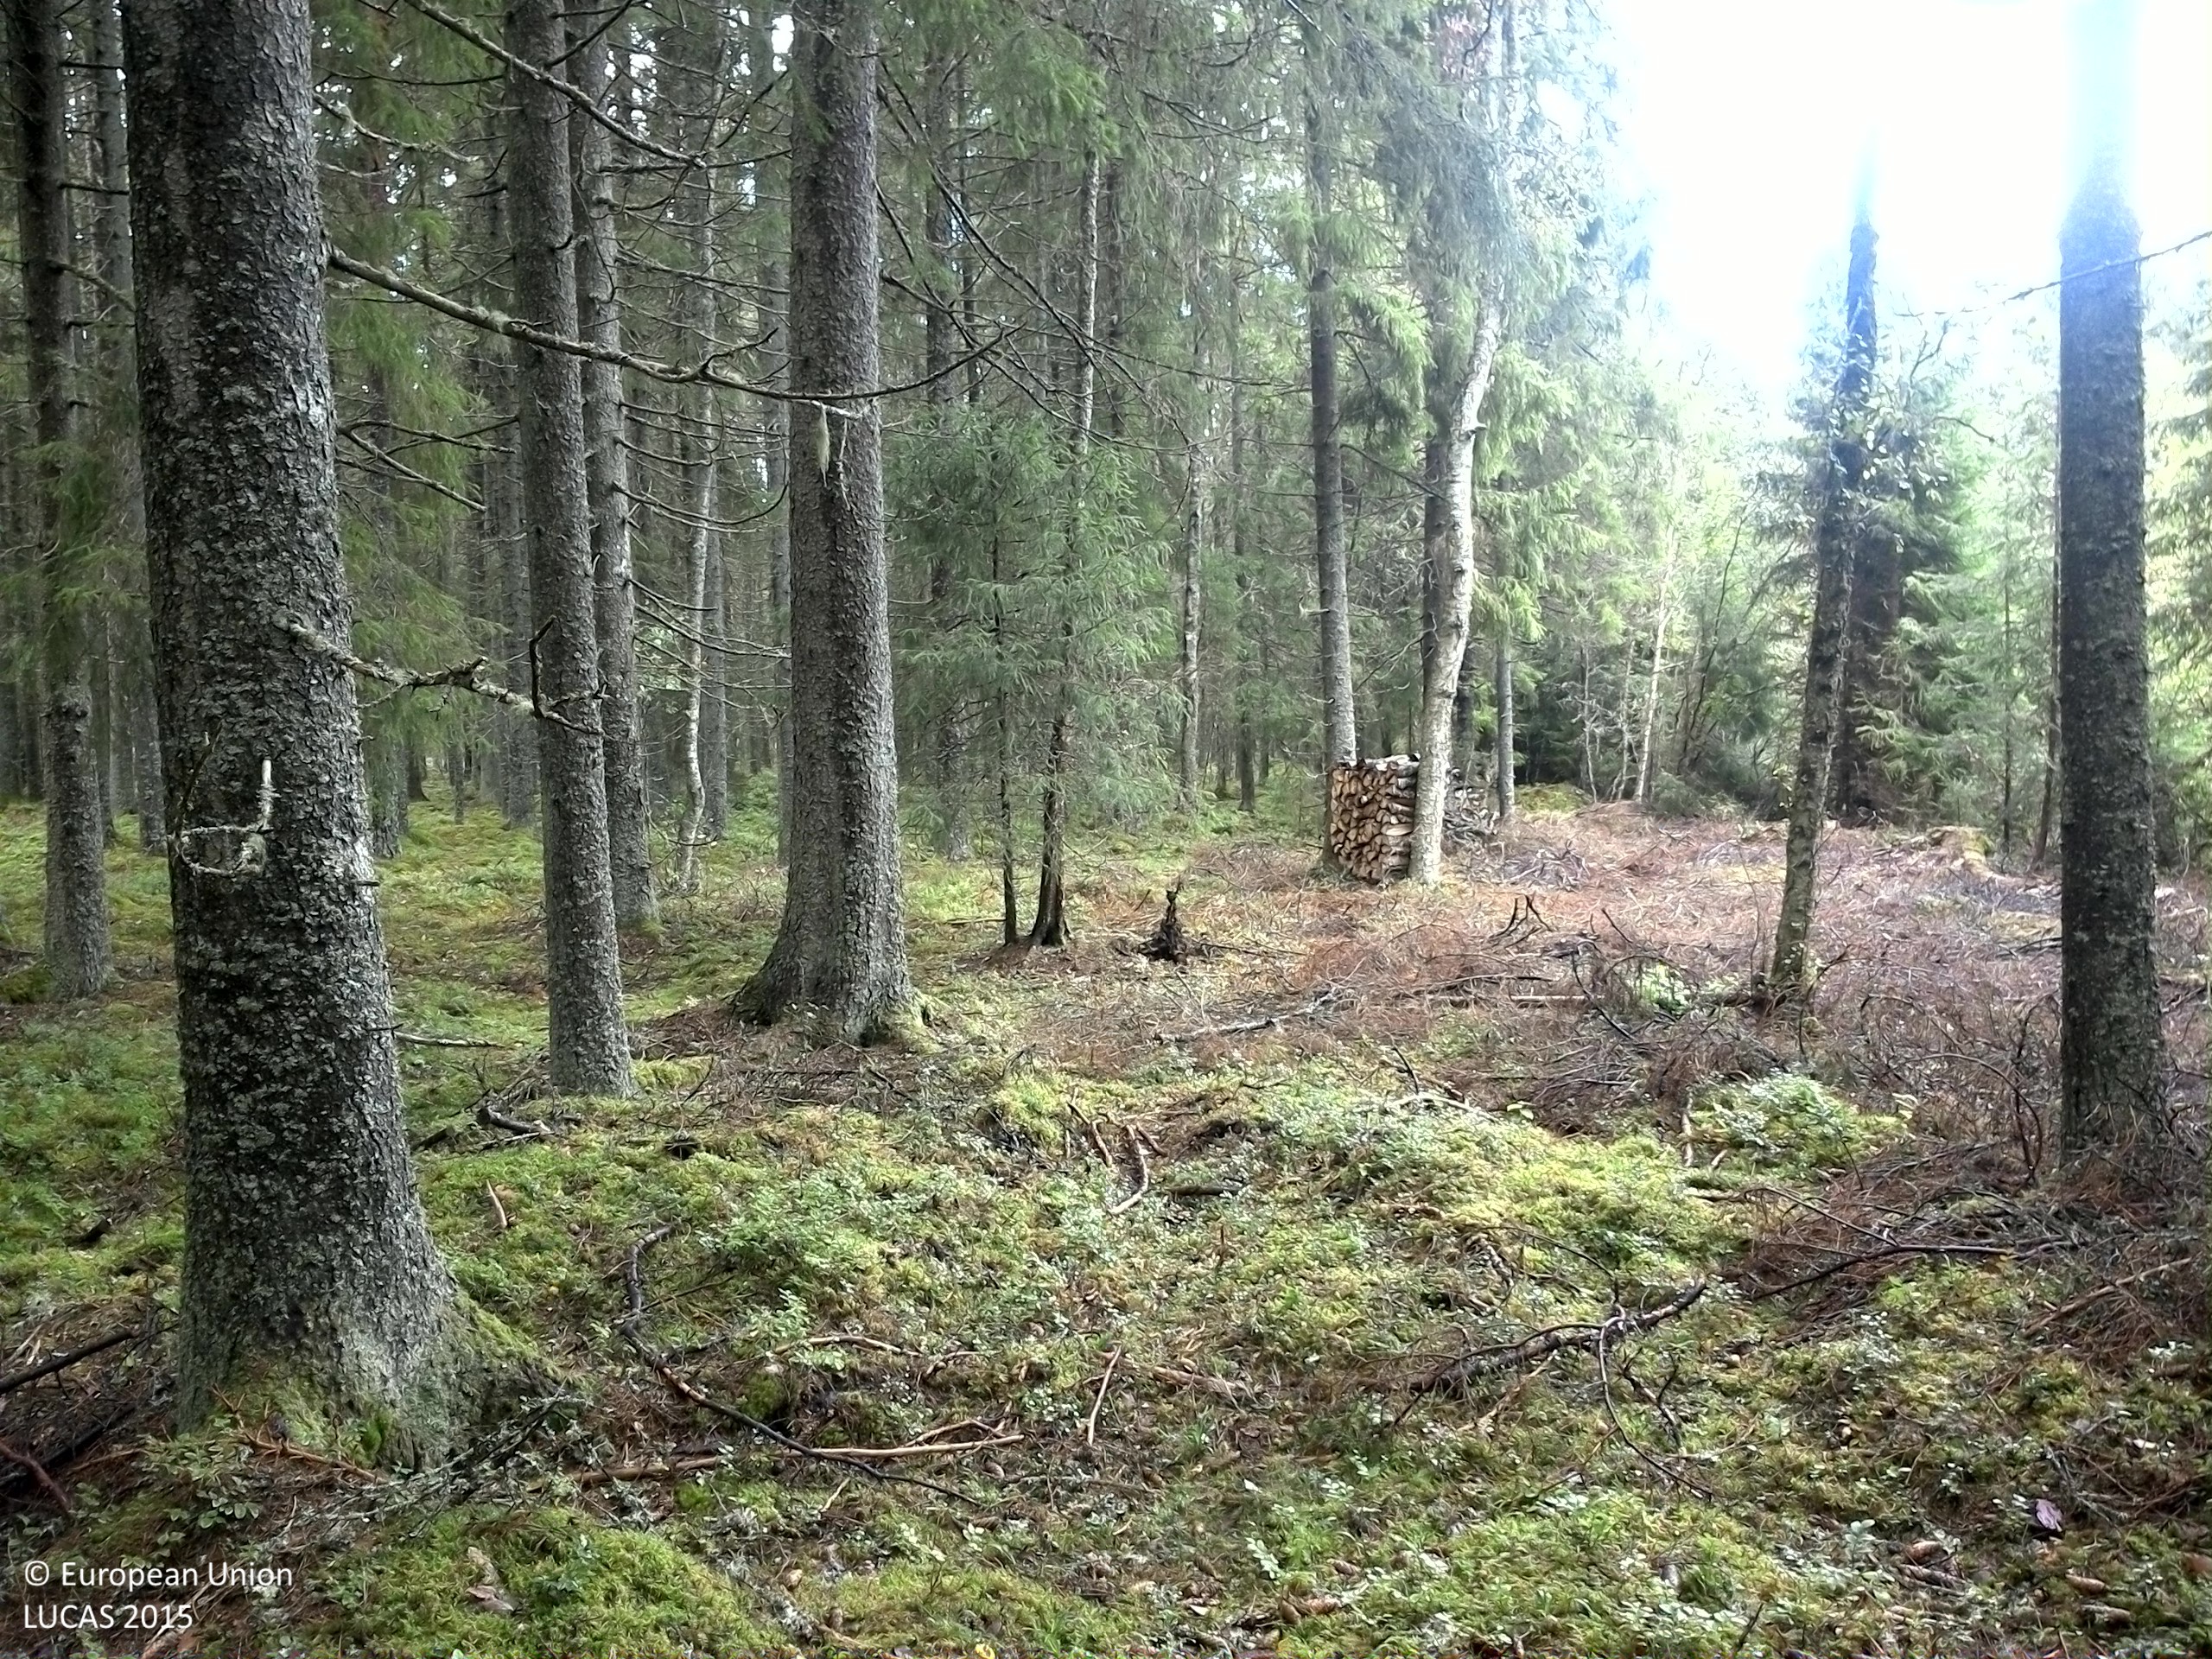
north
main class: Woodland
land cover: Spruce dominated coniferous woodland
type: boreal forest
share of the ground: 50 - 75 %
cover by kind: coniferous forest trees 65 %, shrubs 15 %, lichens and mosses 15 %, broadleaved forest trees 5 %
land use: Forestry
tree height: > 5 m
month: September
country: SE
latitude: 59.2846
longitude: 11.9785
